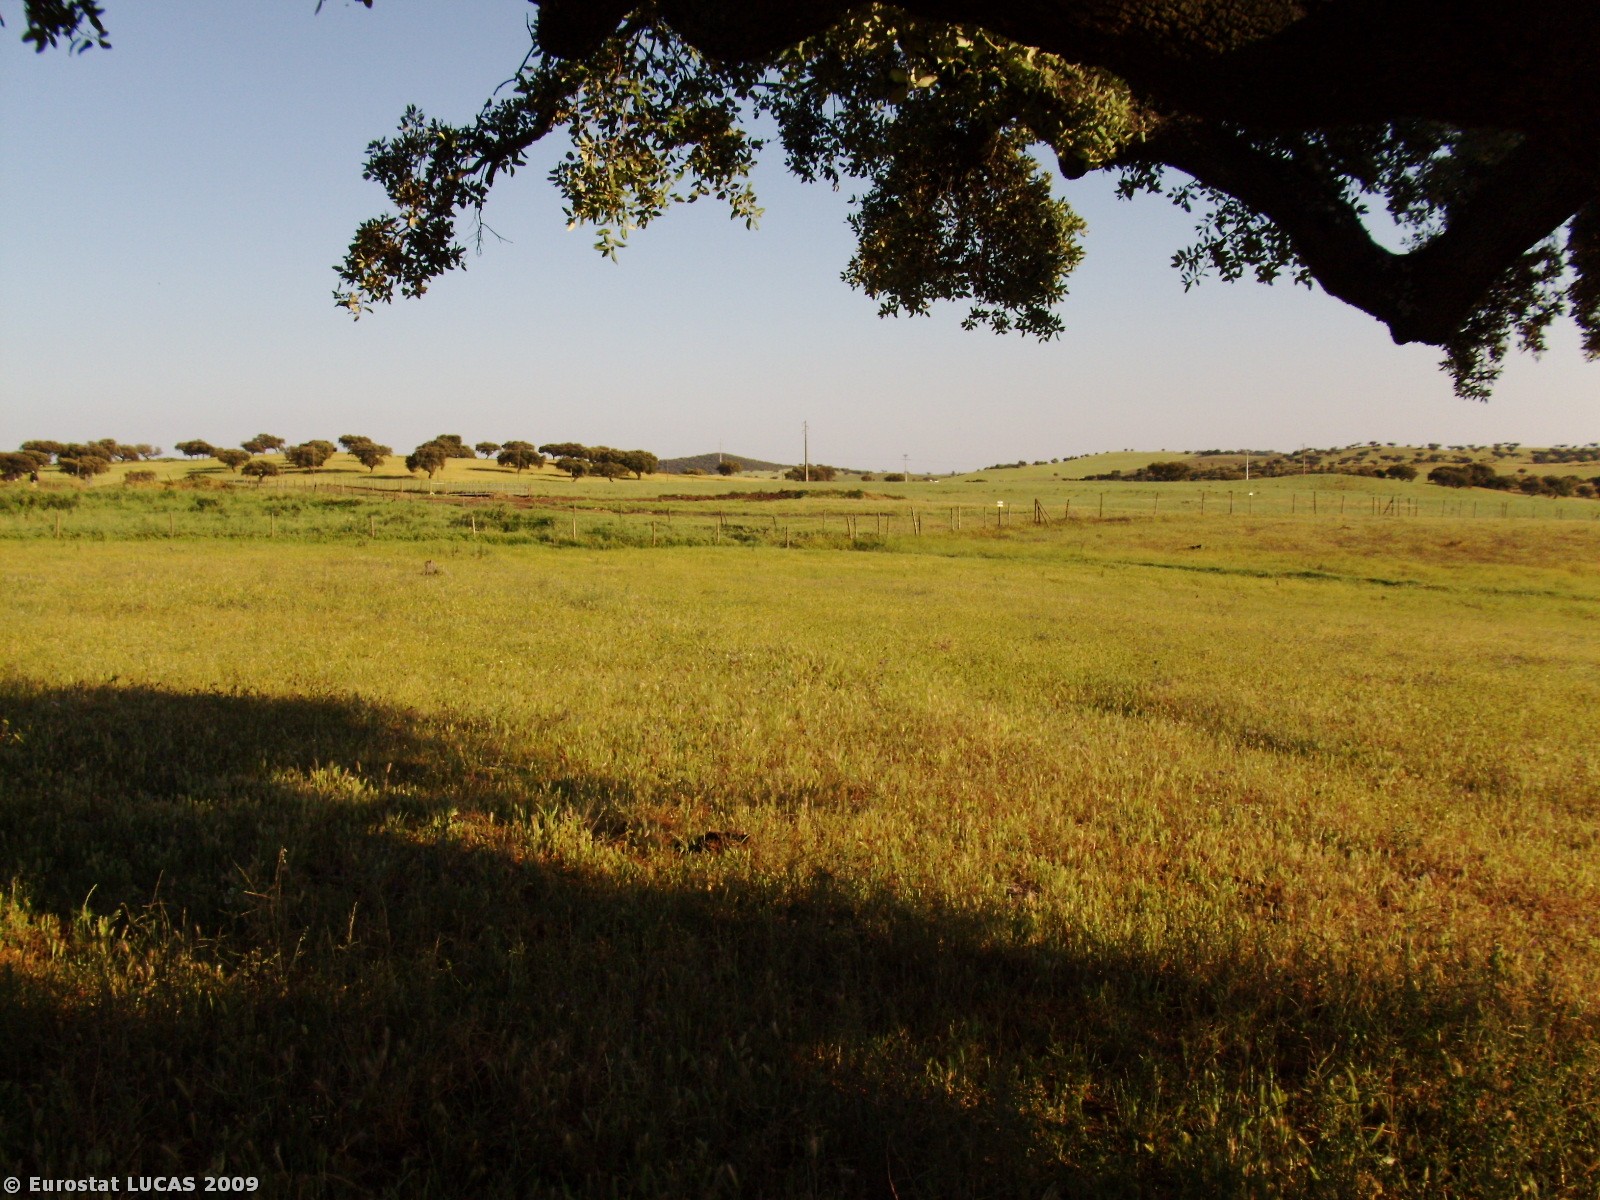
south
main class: Woodland
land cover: Broadleaved woodland
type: broadleaved evergreen forest
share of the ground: 10 - 25 %
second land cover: Spontaneously vegetated surfaces
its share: 25 - 50 %
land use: Agriculture (excluding fallow land and kitchen gardens)
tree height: > 5 m
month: May
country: PT
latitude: 38.7933
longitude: -7.2875
